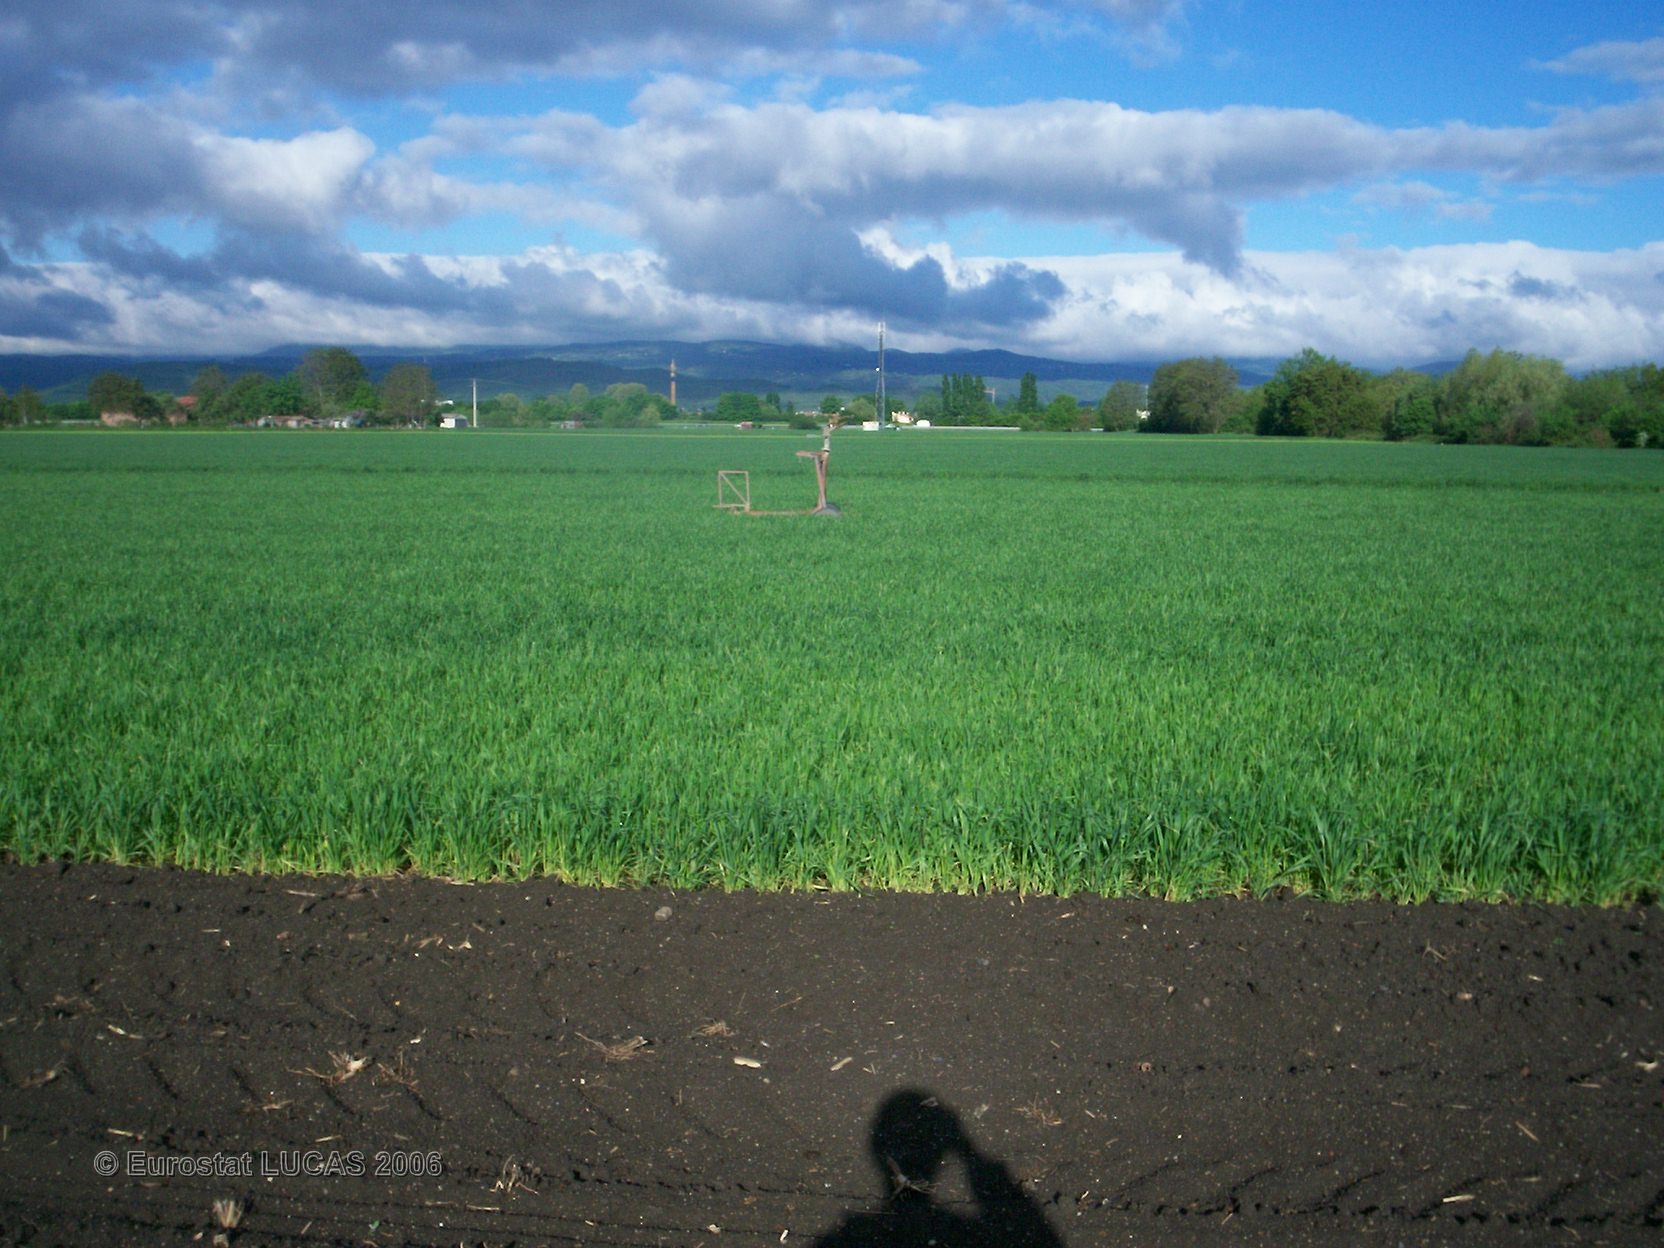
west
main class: Cropland
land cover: Maize
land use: Agriculture (excluding fallow land and kitchen gardens)
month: May
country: FR
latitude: 45.8252
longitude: 3.1648
